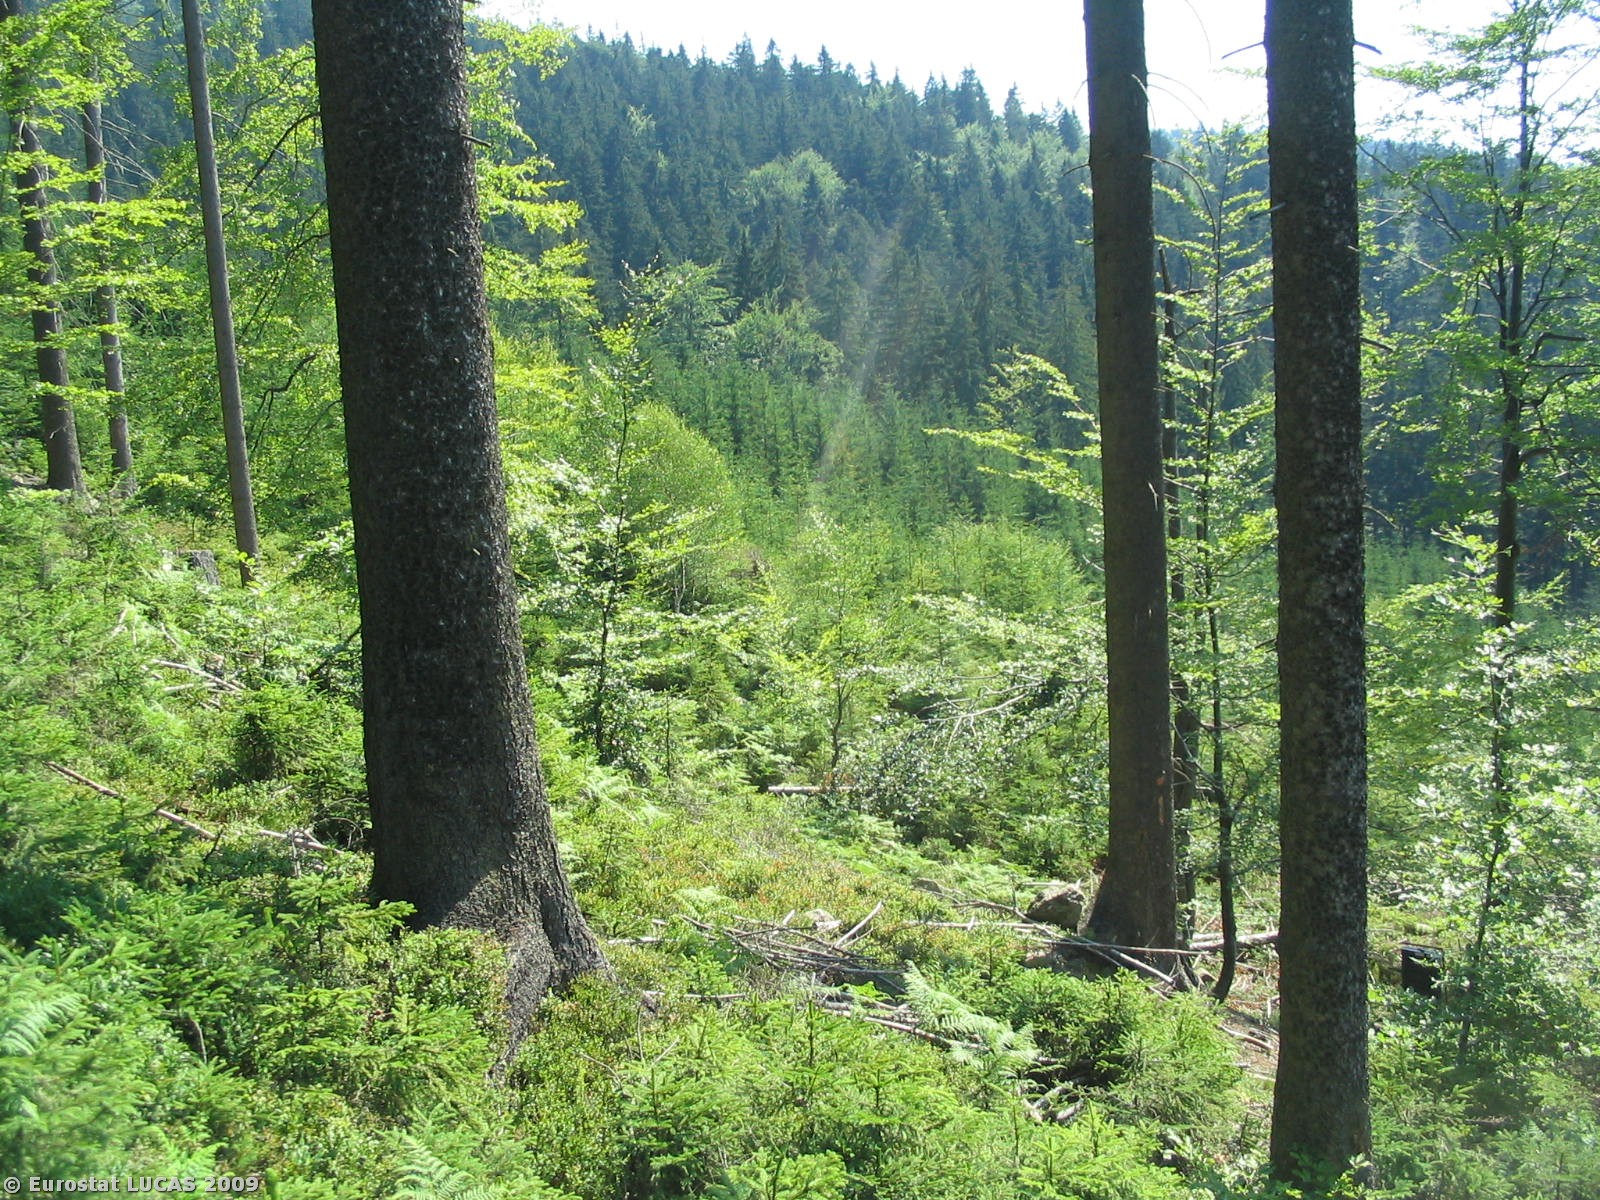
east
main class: Woodland
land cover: Mixed woodland
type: mountainous beech forest
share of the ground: > 75 %
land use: Forestry
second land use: Nature reserves
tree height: > 5 m
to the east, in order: Mixed woodland; Coniferous woodland; Tracks; Mixed woodland; Rivers and streams; Mixed woodland
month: July
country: CZ
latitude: 49.5876
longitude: 18.8326
